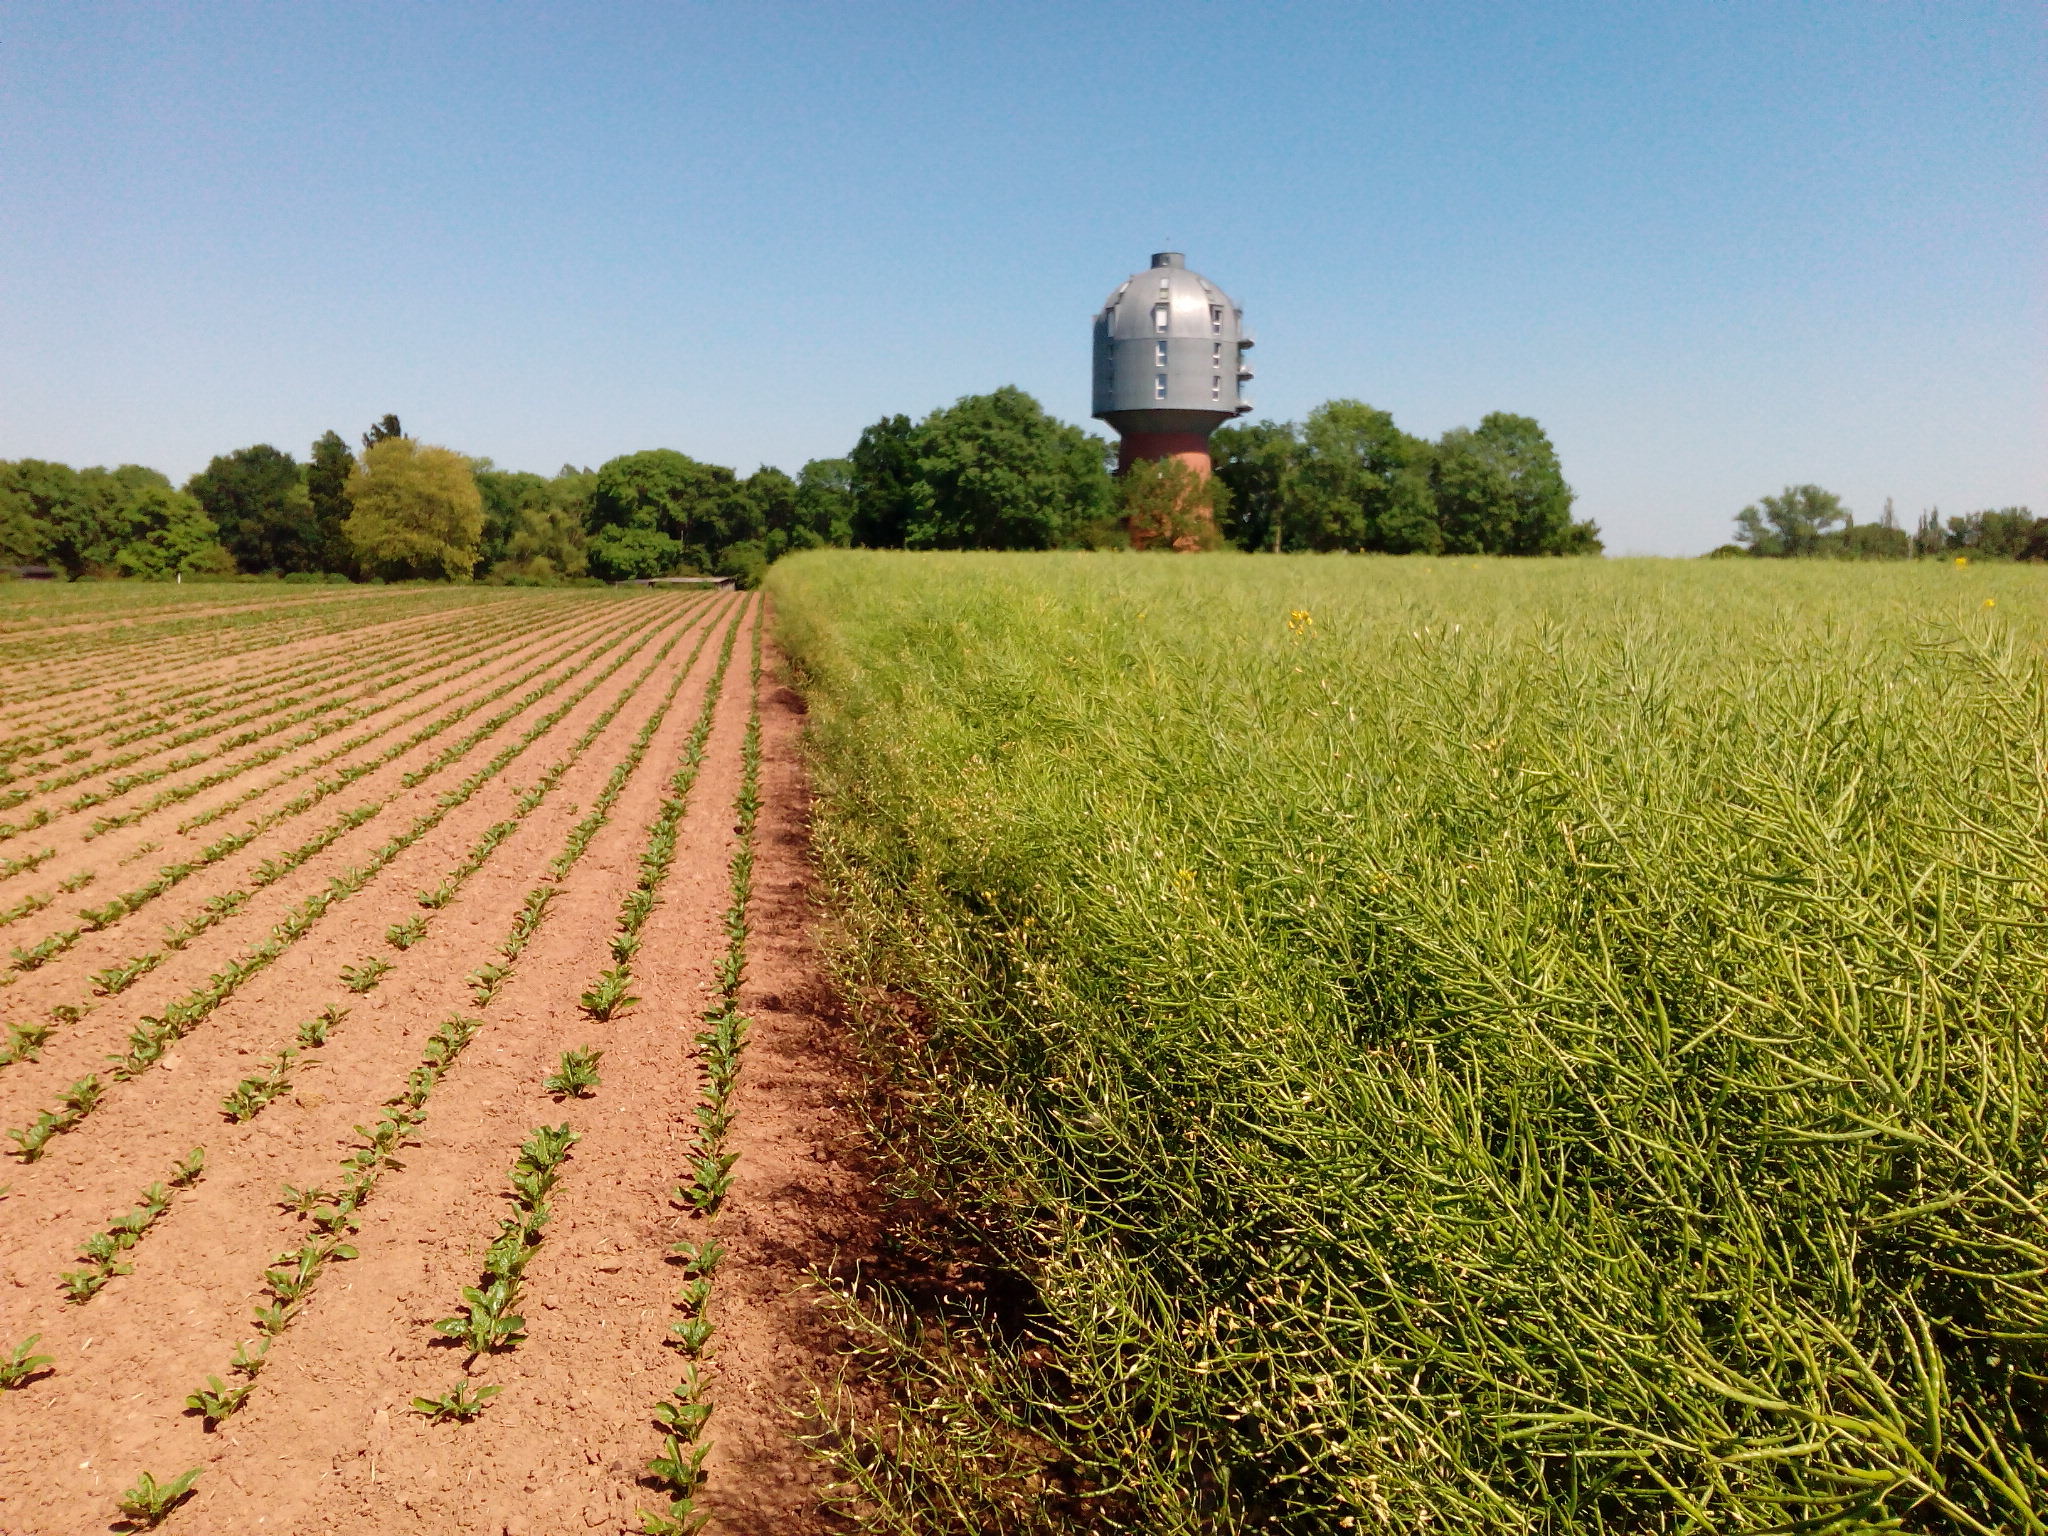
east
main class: Cropland
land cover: Rape and turnip rape
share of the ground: > 75 %
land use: Agriculture (excluding fallow land and kitchen gardens)
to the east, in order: Rape and turnip rape
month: June
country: DE
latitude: 52.2876
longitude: 9.9267
